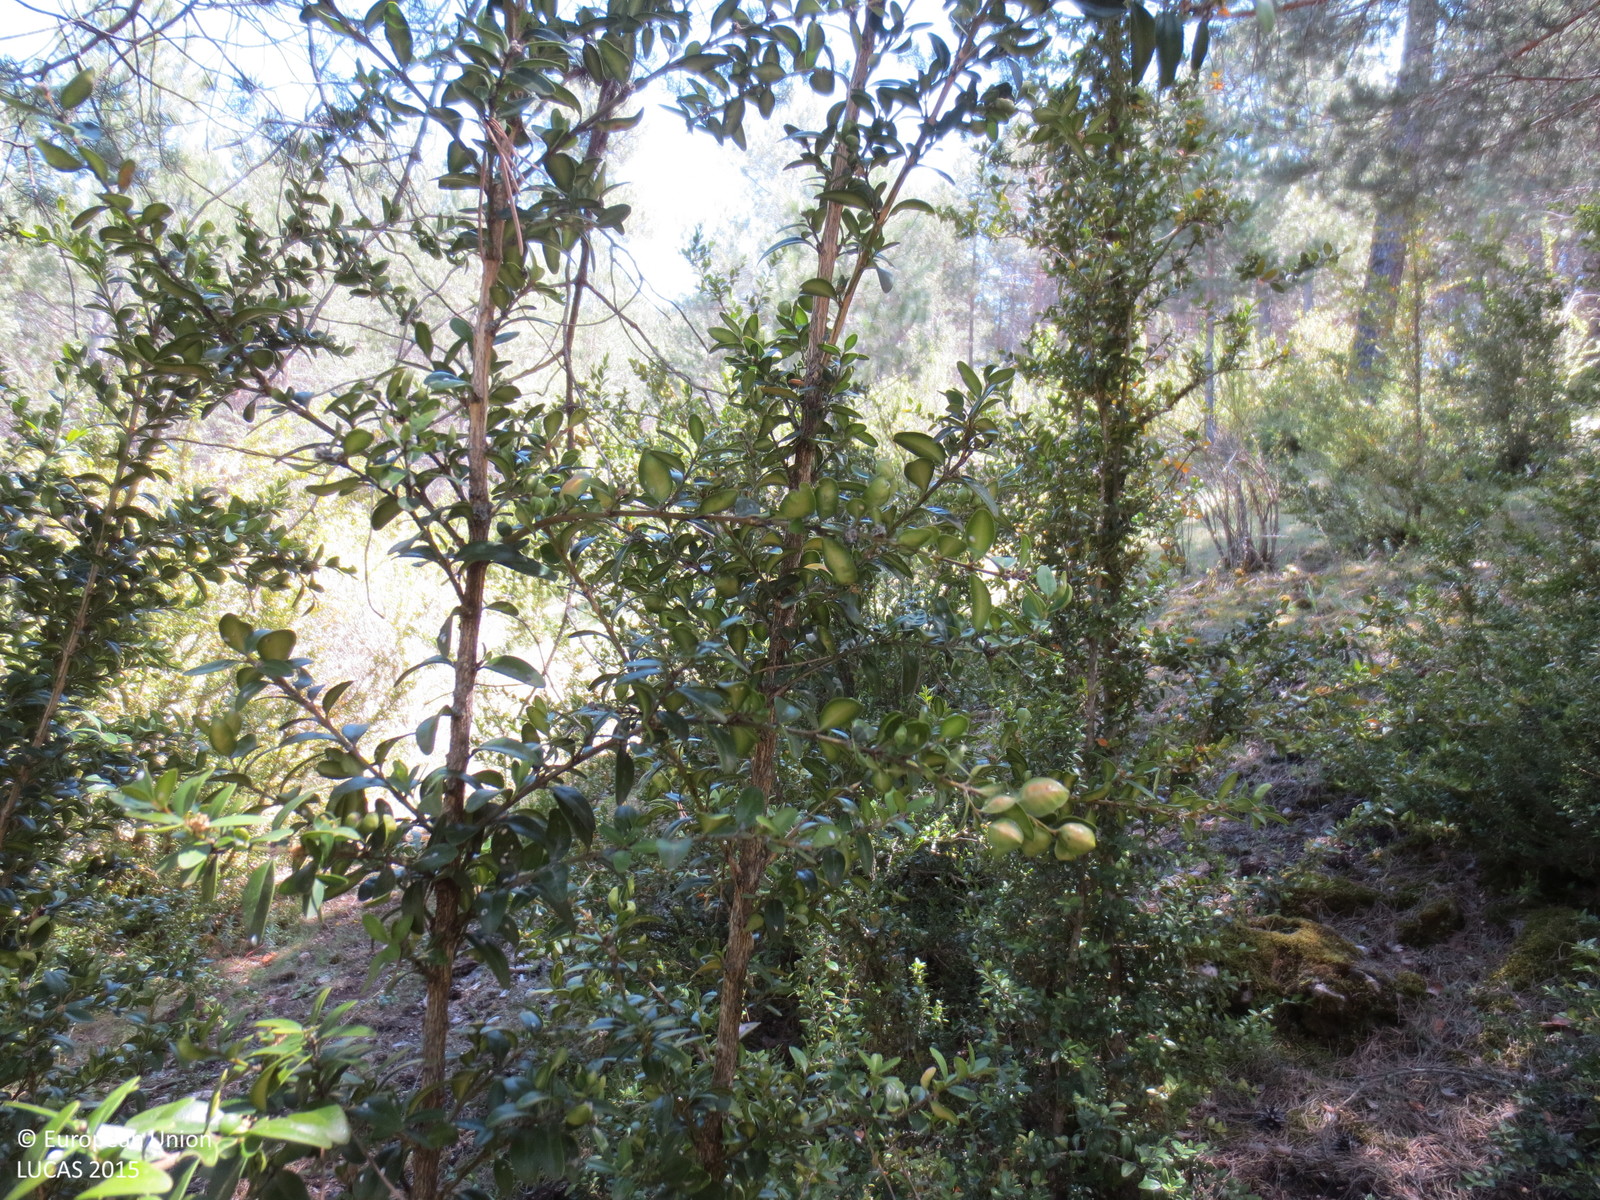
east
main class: Woodland
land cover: Pine dominated coniferous woodland
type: coniferous forest of the mediterranean region
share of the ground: 50 - 75 %
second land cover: Shrubland without tree cover
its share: 25 - 50 %
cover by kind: coniferous forest trees 60 %, shrubs 30 %, herbaceous plants 10 %
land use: Forestry
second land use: Agriculture (excluding fallow land and kitchen gardens)
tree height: > 5 m
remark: Clear cut
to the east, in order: Pine dominated coniferous woodland; Shrubland without tree cover; Pine dominated coniferous woodland
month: May
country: ES
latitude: 40.3717
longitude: -1.9718
